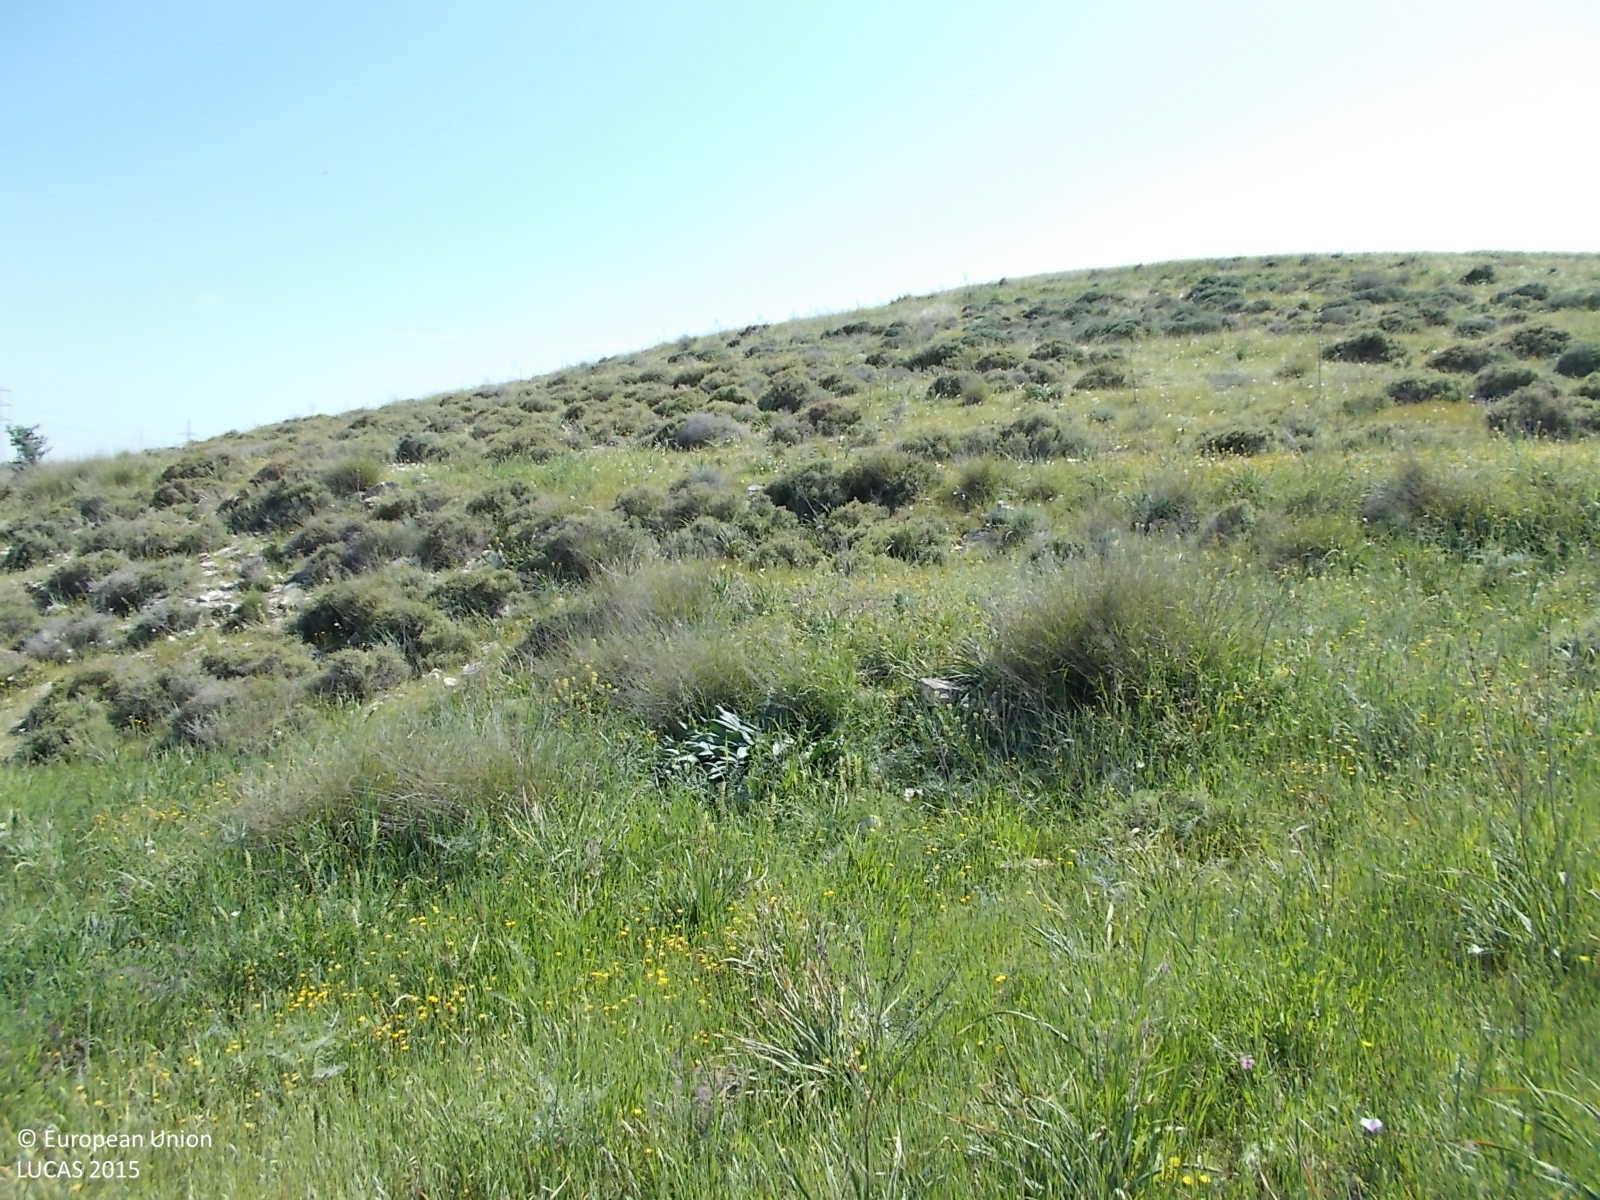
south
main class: Shrubland
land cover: Shrubland without tree cover
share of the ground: 50 - 75 %
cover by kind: shrubs 60 %, herbaceous plants 40 %
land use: Semi-natural and natural areas not in use
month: April
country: CY
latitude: 34.9916
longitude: 33.5418
